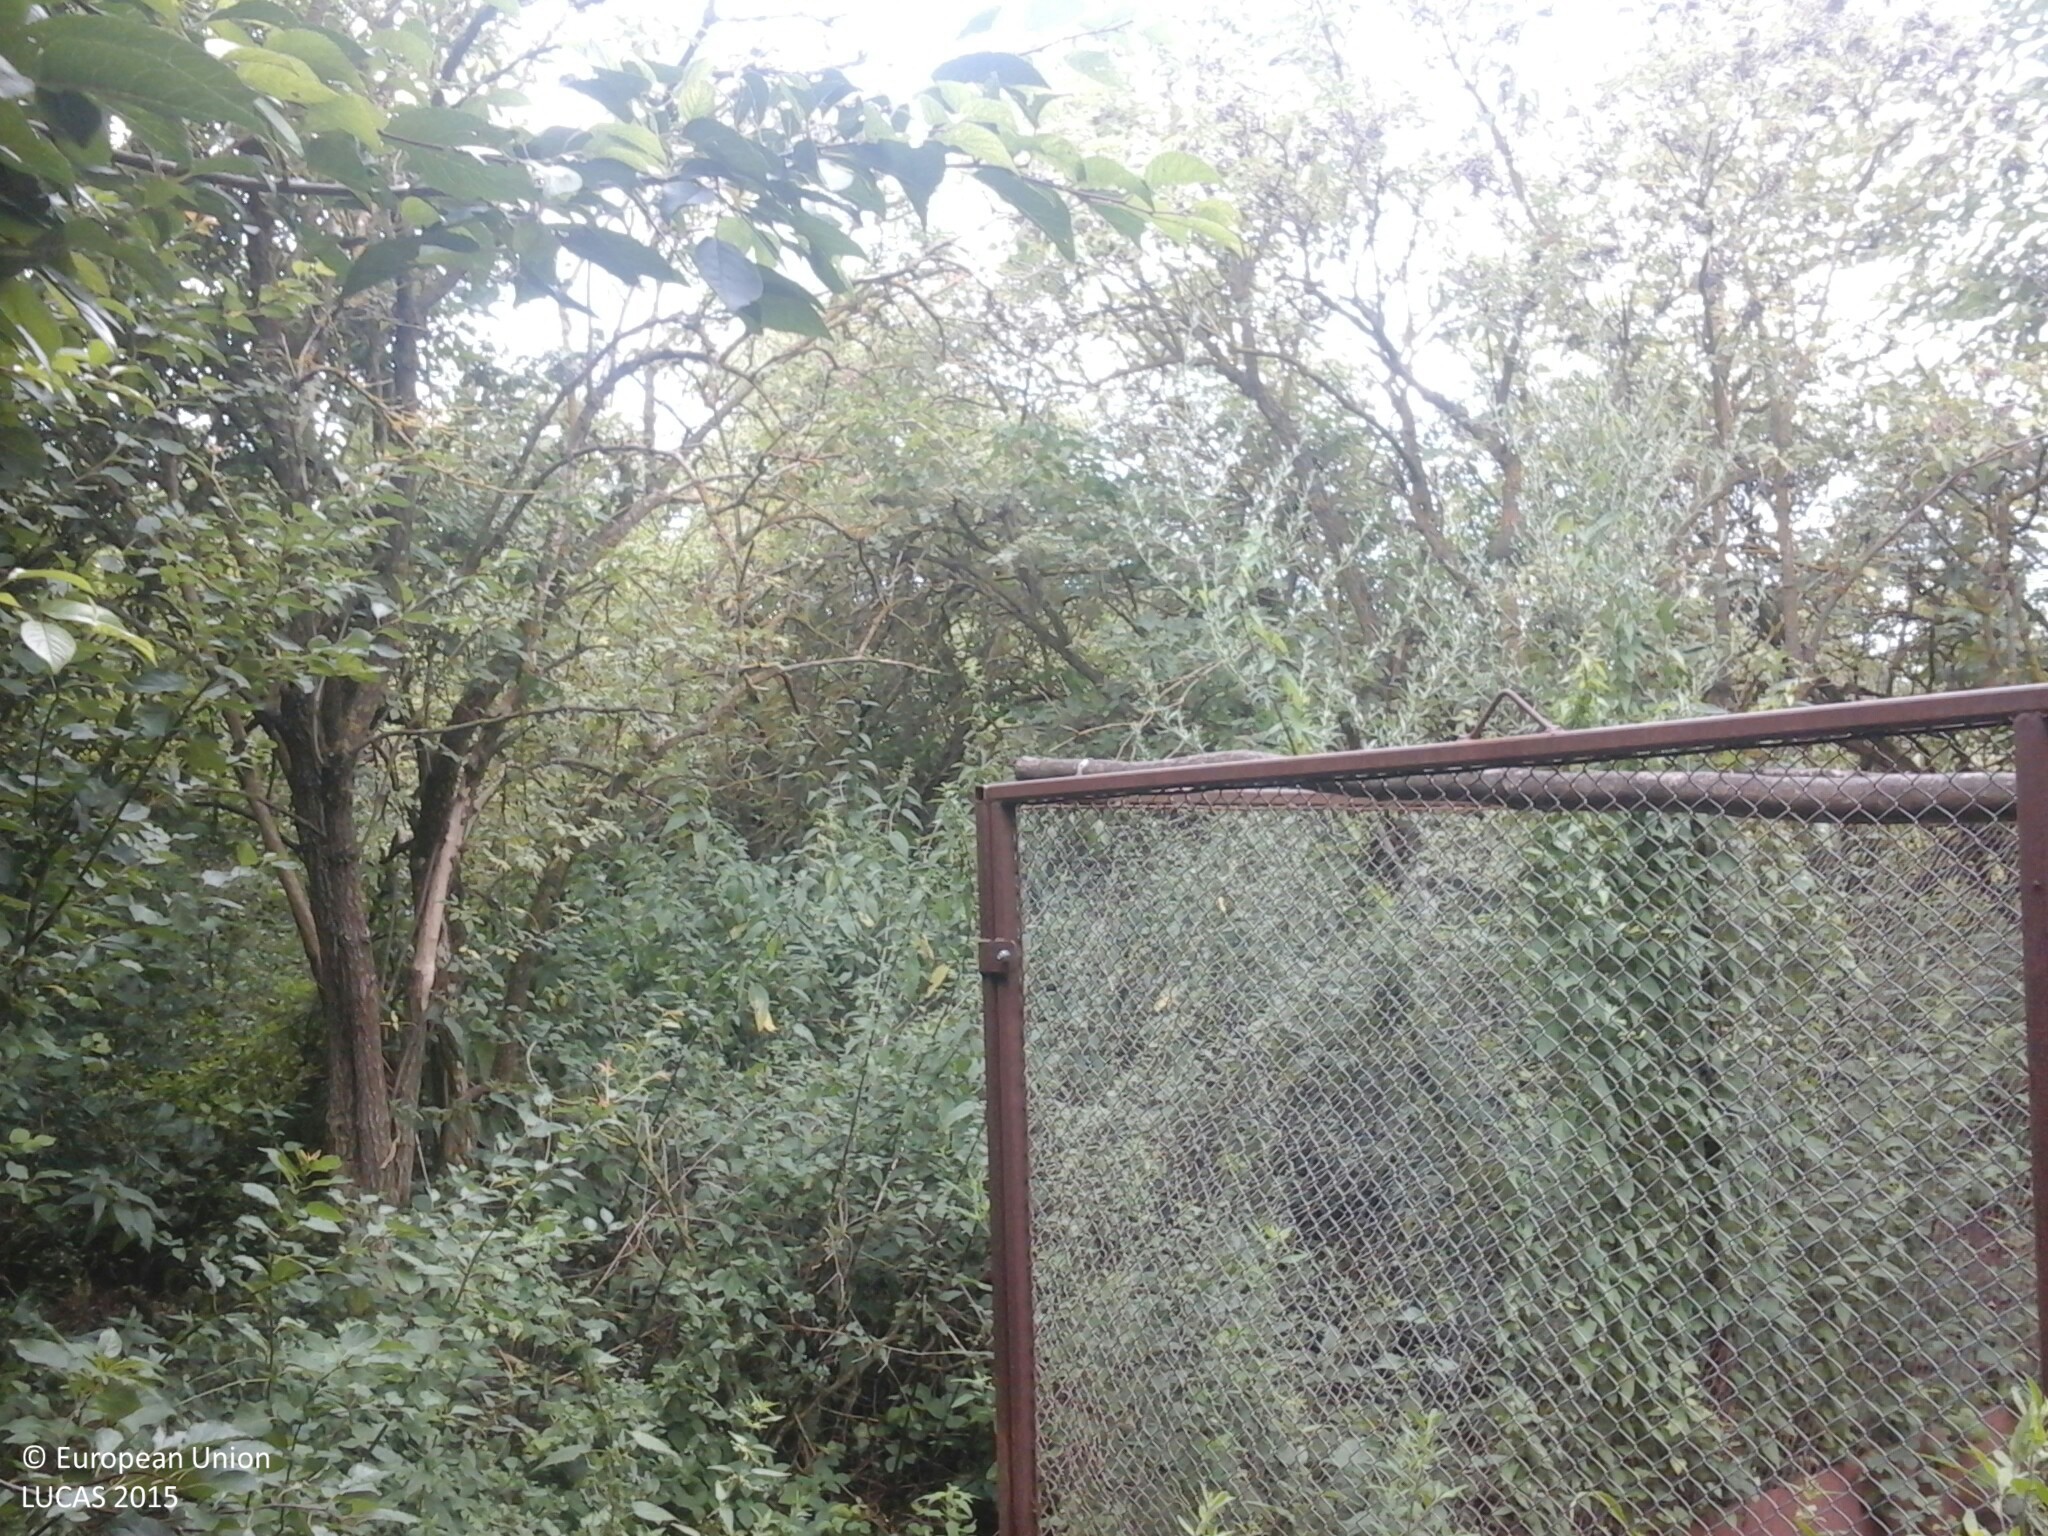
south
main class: Shrubland
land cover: Shrubland with sparse tree cover
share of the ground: > 75 %
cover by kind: shrubs 75 %, herbaceous plants 20 %, broadleaved forest trees 5 %
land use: Abandoned areas
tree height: > 5 m
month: July
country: HU
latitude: 46.9787
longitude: 17.9357
